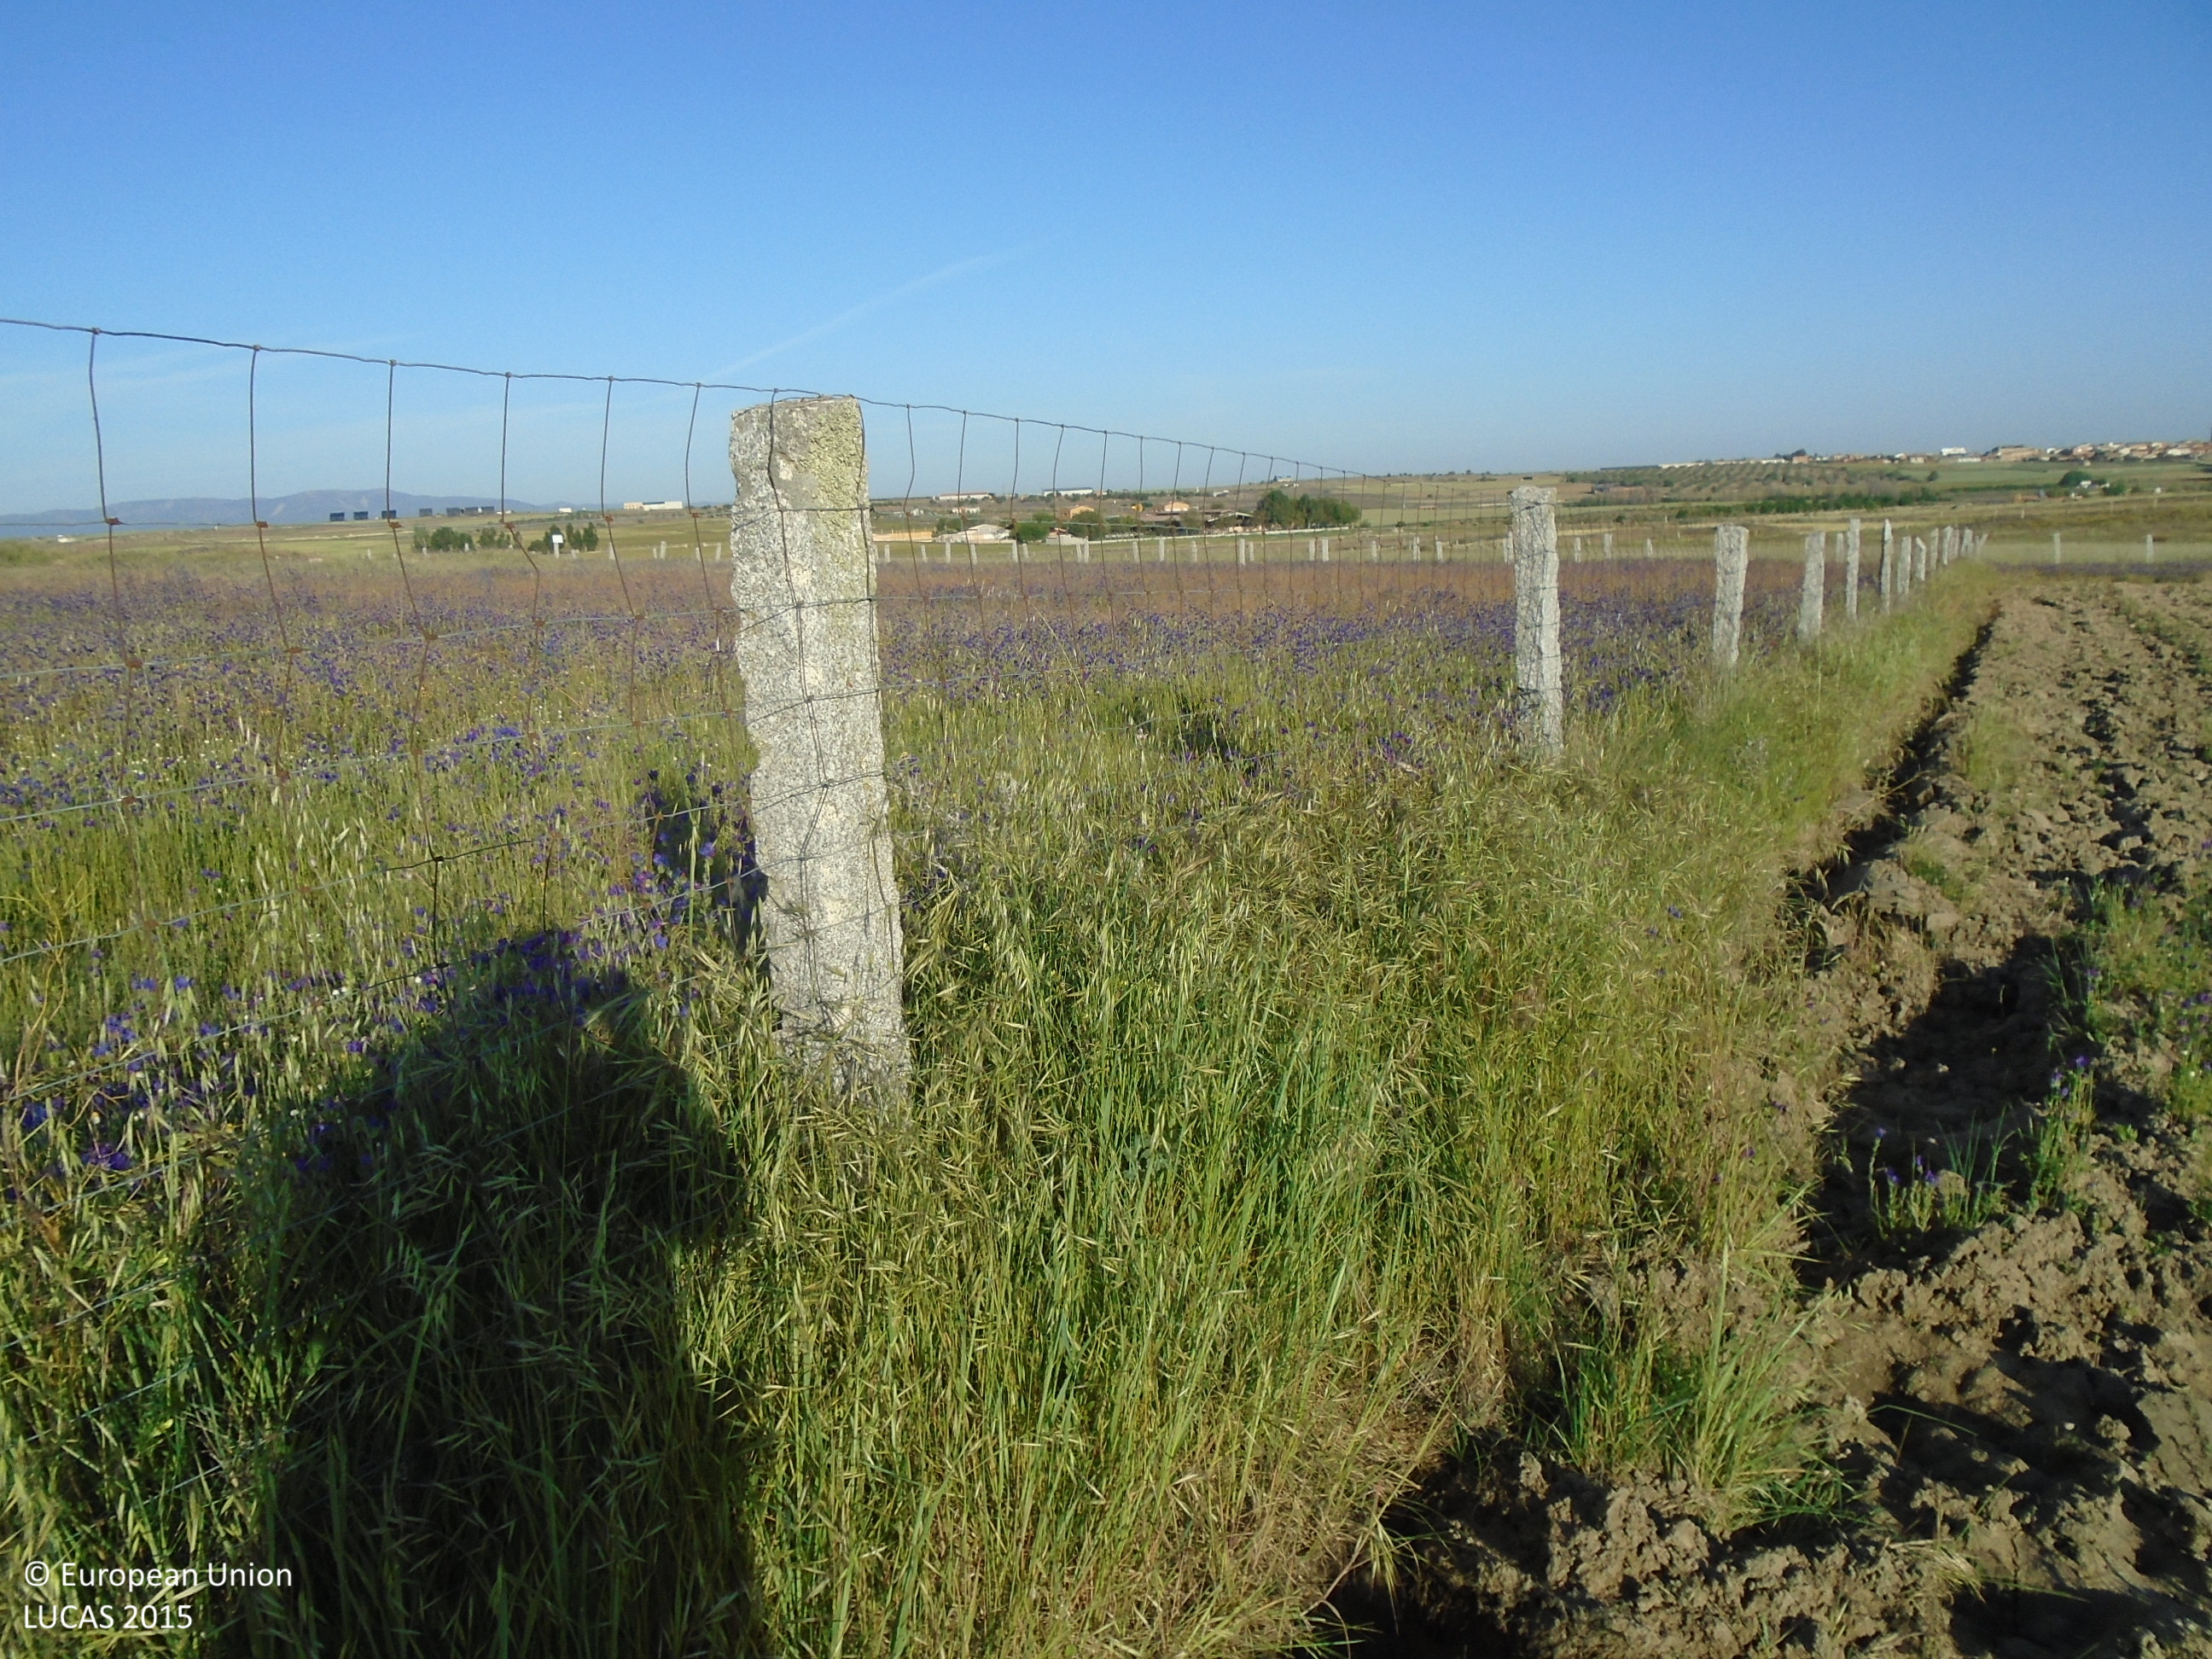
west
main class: Grassland
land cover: Spontaneously vegetated surfaces
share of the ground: > 75 %
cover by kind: herbaceous plants 100 %
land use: Agriculture (excluding fallow land and kitchen gardens)
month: May
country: ES
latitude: 39.6514
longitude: -4.1937
